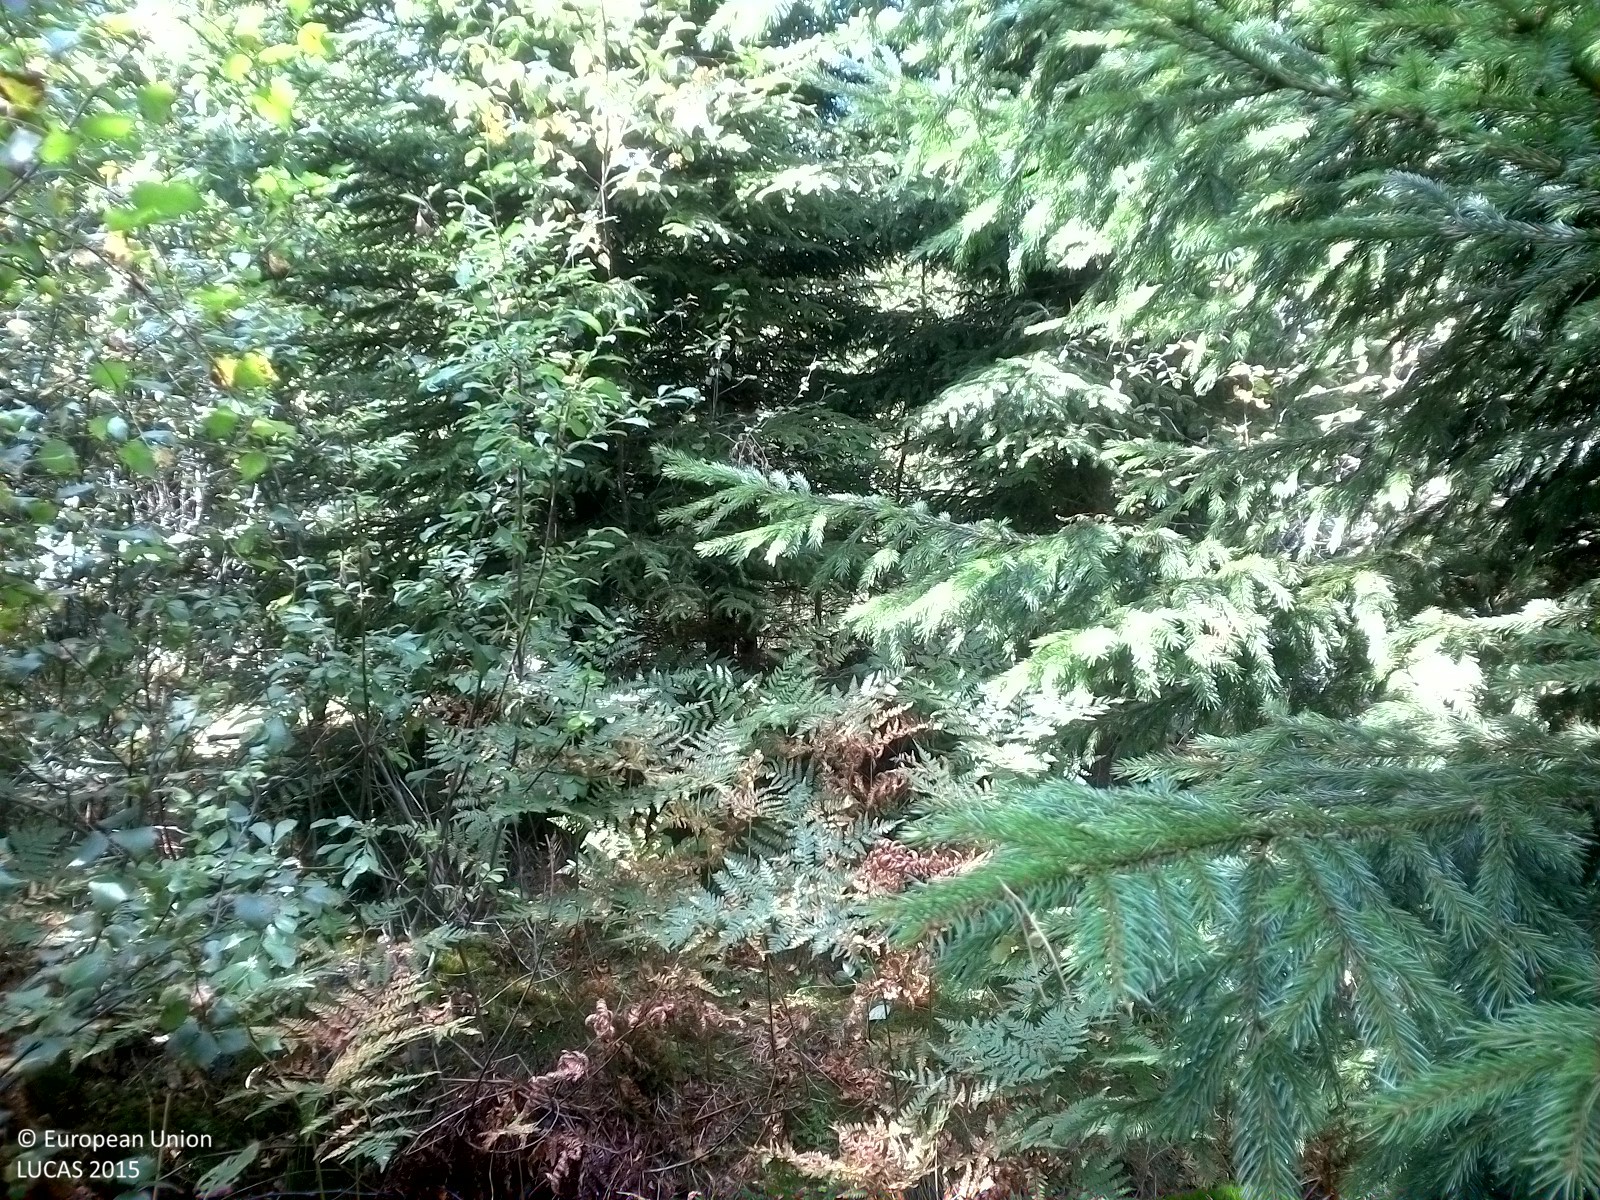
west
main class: Woodland
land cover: Spruce dominated mixed woodland
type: boreal forest
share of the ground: 50 - 75 %
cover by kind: coniferous forest trees 40 %, broadleaved forest trees 30 %, herbaceous plants 20 %, lichens and mosses 10 %
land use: Forestry
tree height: < 5 m
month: August
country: SE
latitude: 58.6132
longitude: 15.0029
